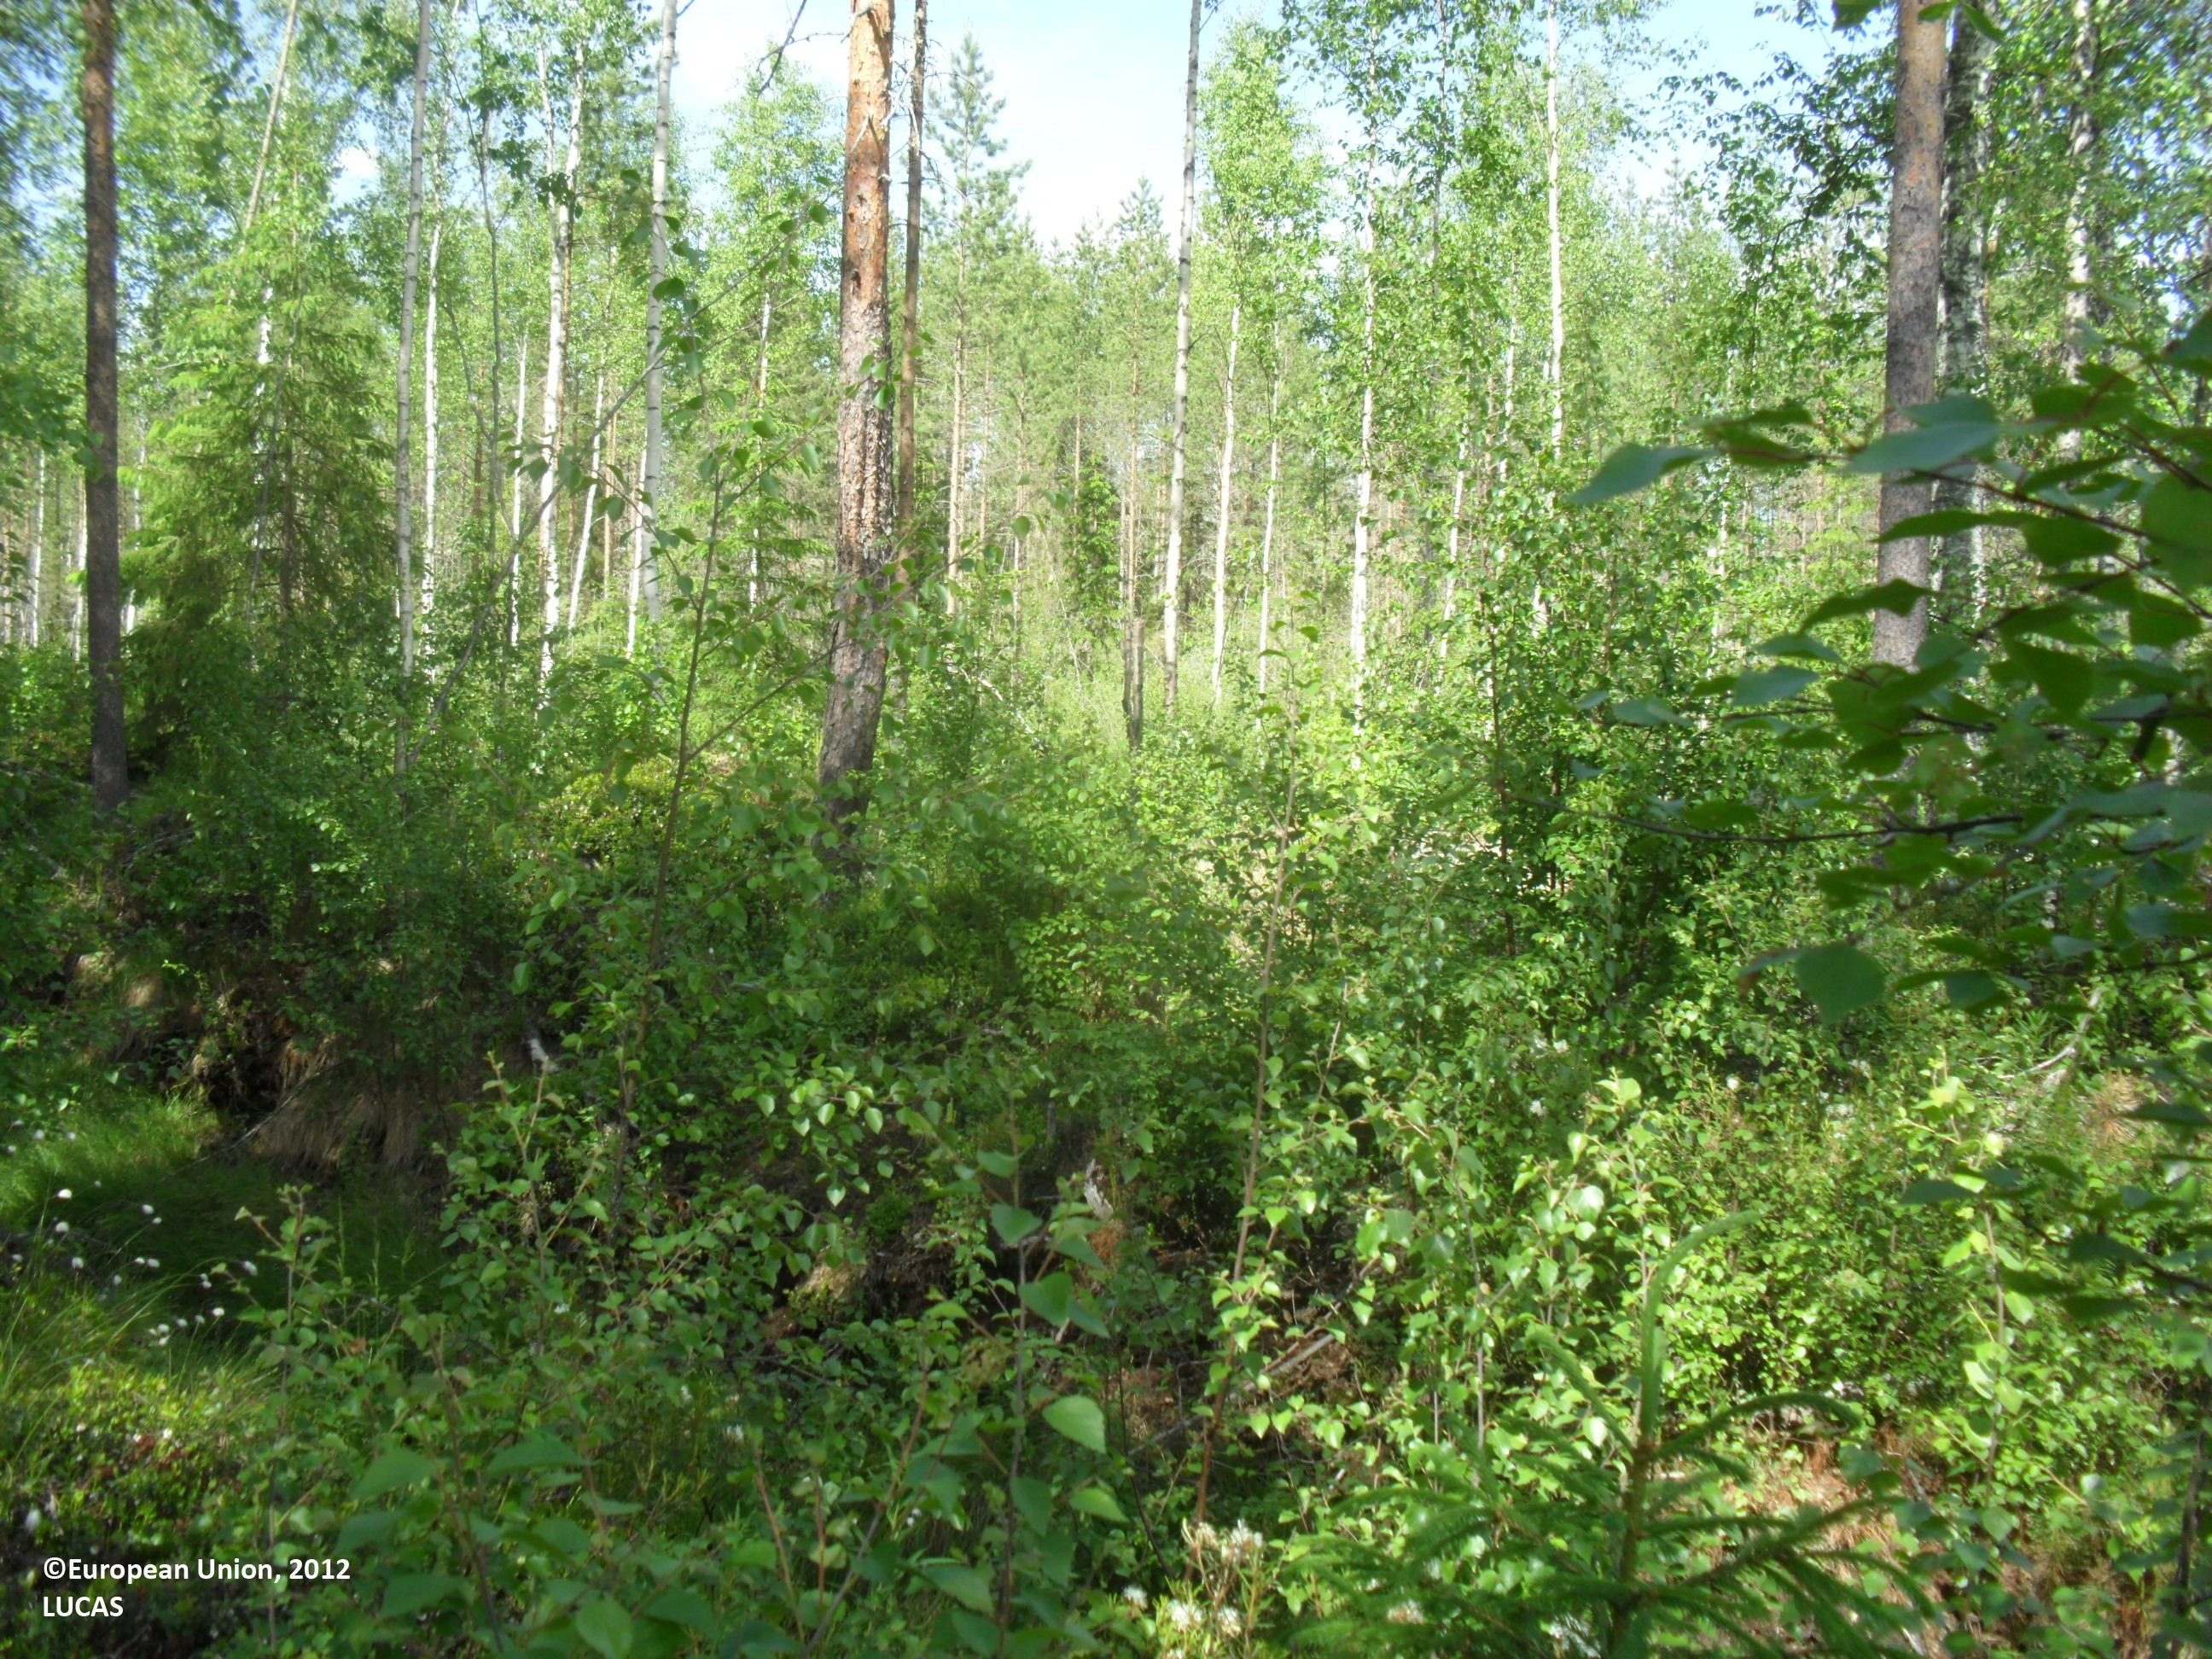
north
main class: Woodland
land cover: Other mixed woodland
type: boreal forest
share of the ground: 25 - 50 %
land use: Forestry
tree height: > 5 m
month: June
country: FI
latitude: 63.3595
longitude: 23.0698
